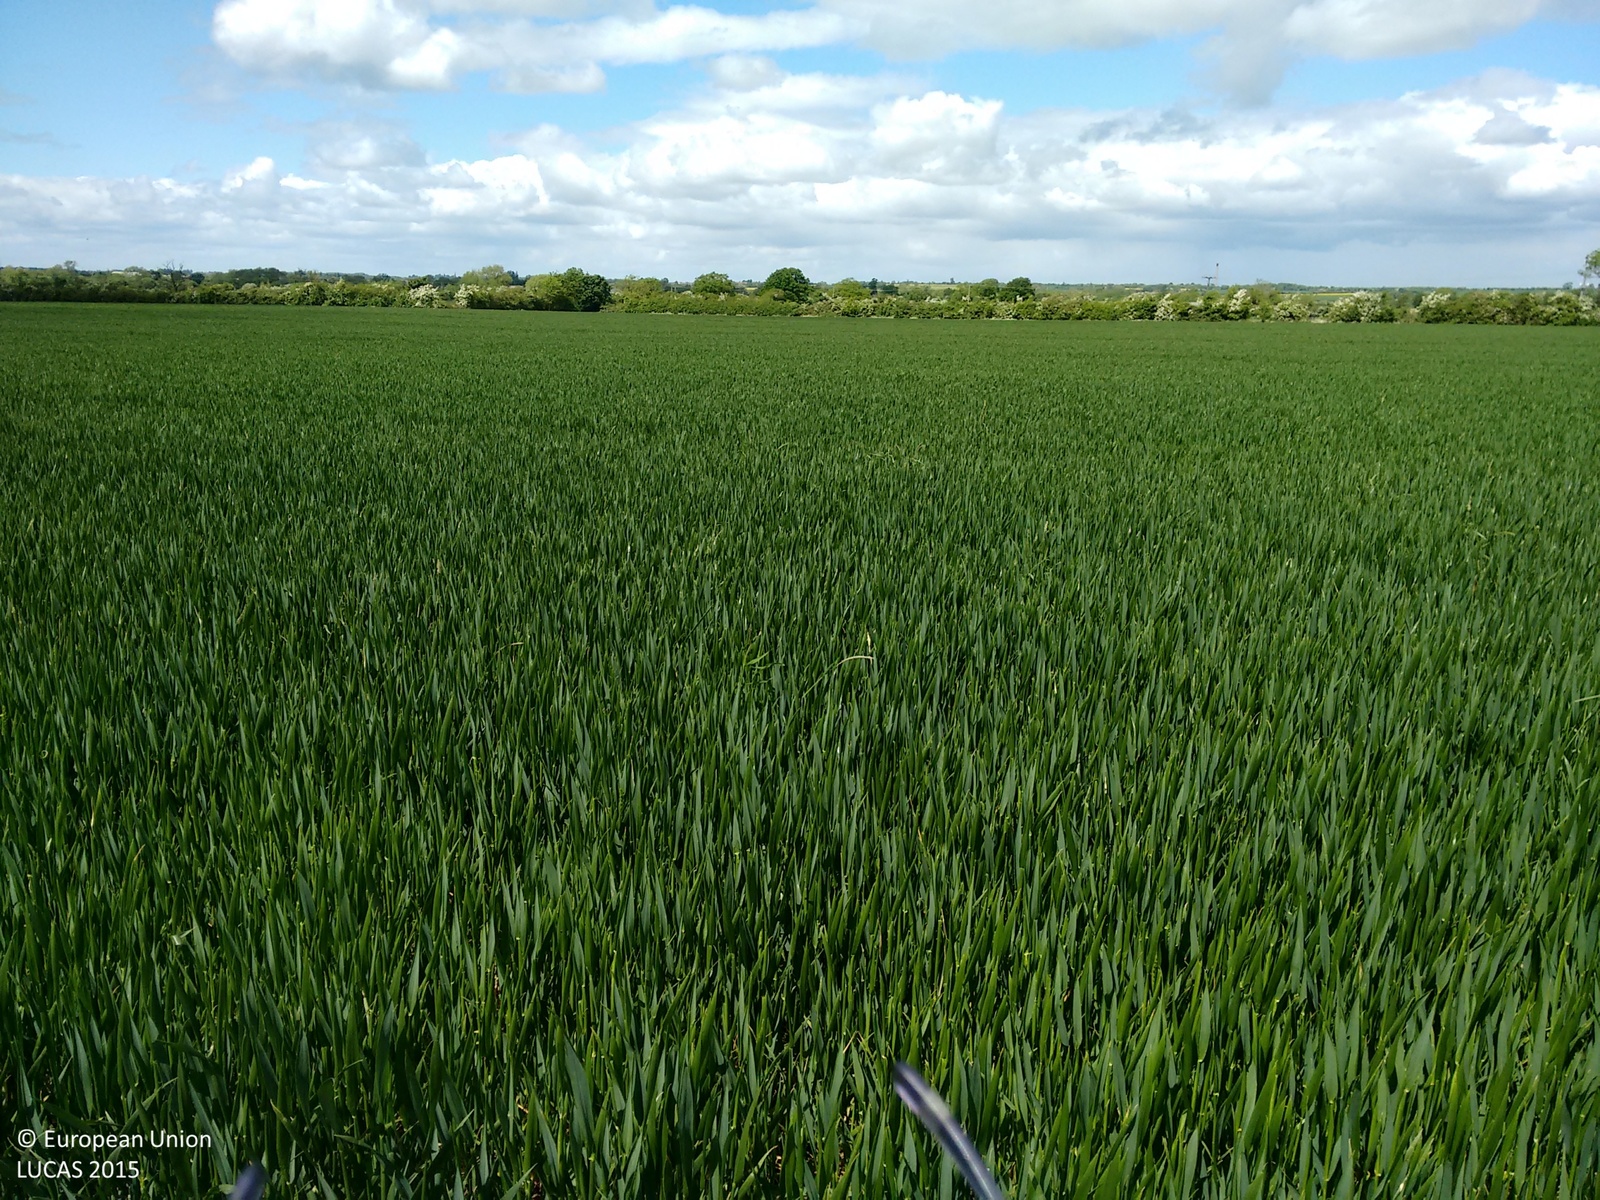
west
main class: Cropland
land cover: Barley
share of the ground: > 75 %
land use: Agriculture (excluding fallow land and kitchen gardens)
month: May
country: GB
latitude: 52.2496
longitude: -1.3421
